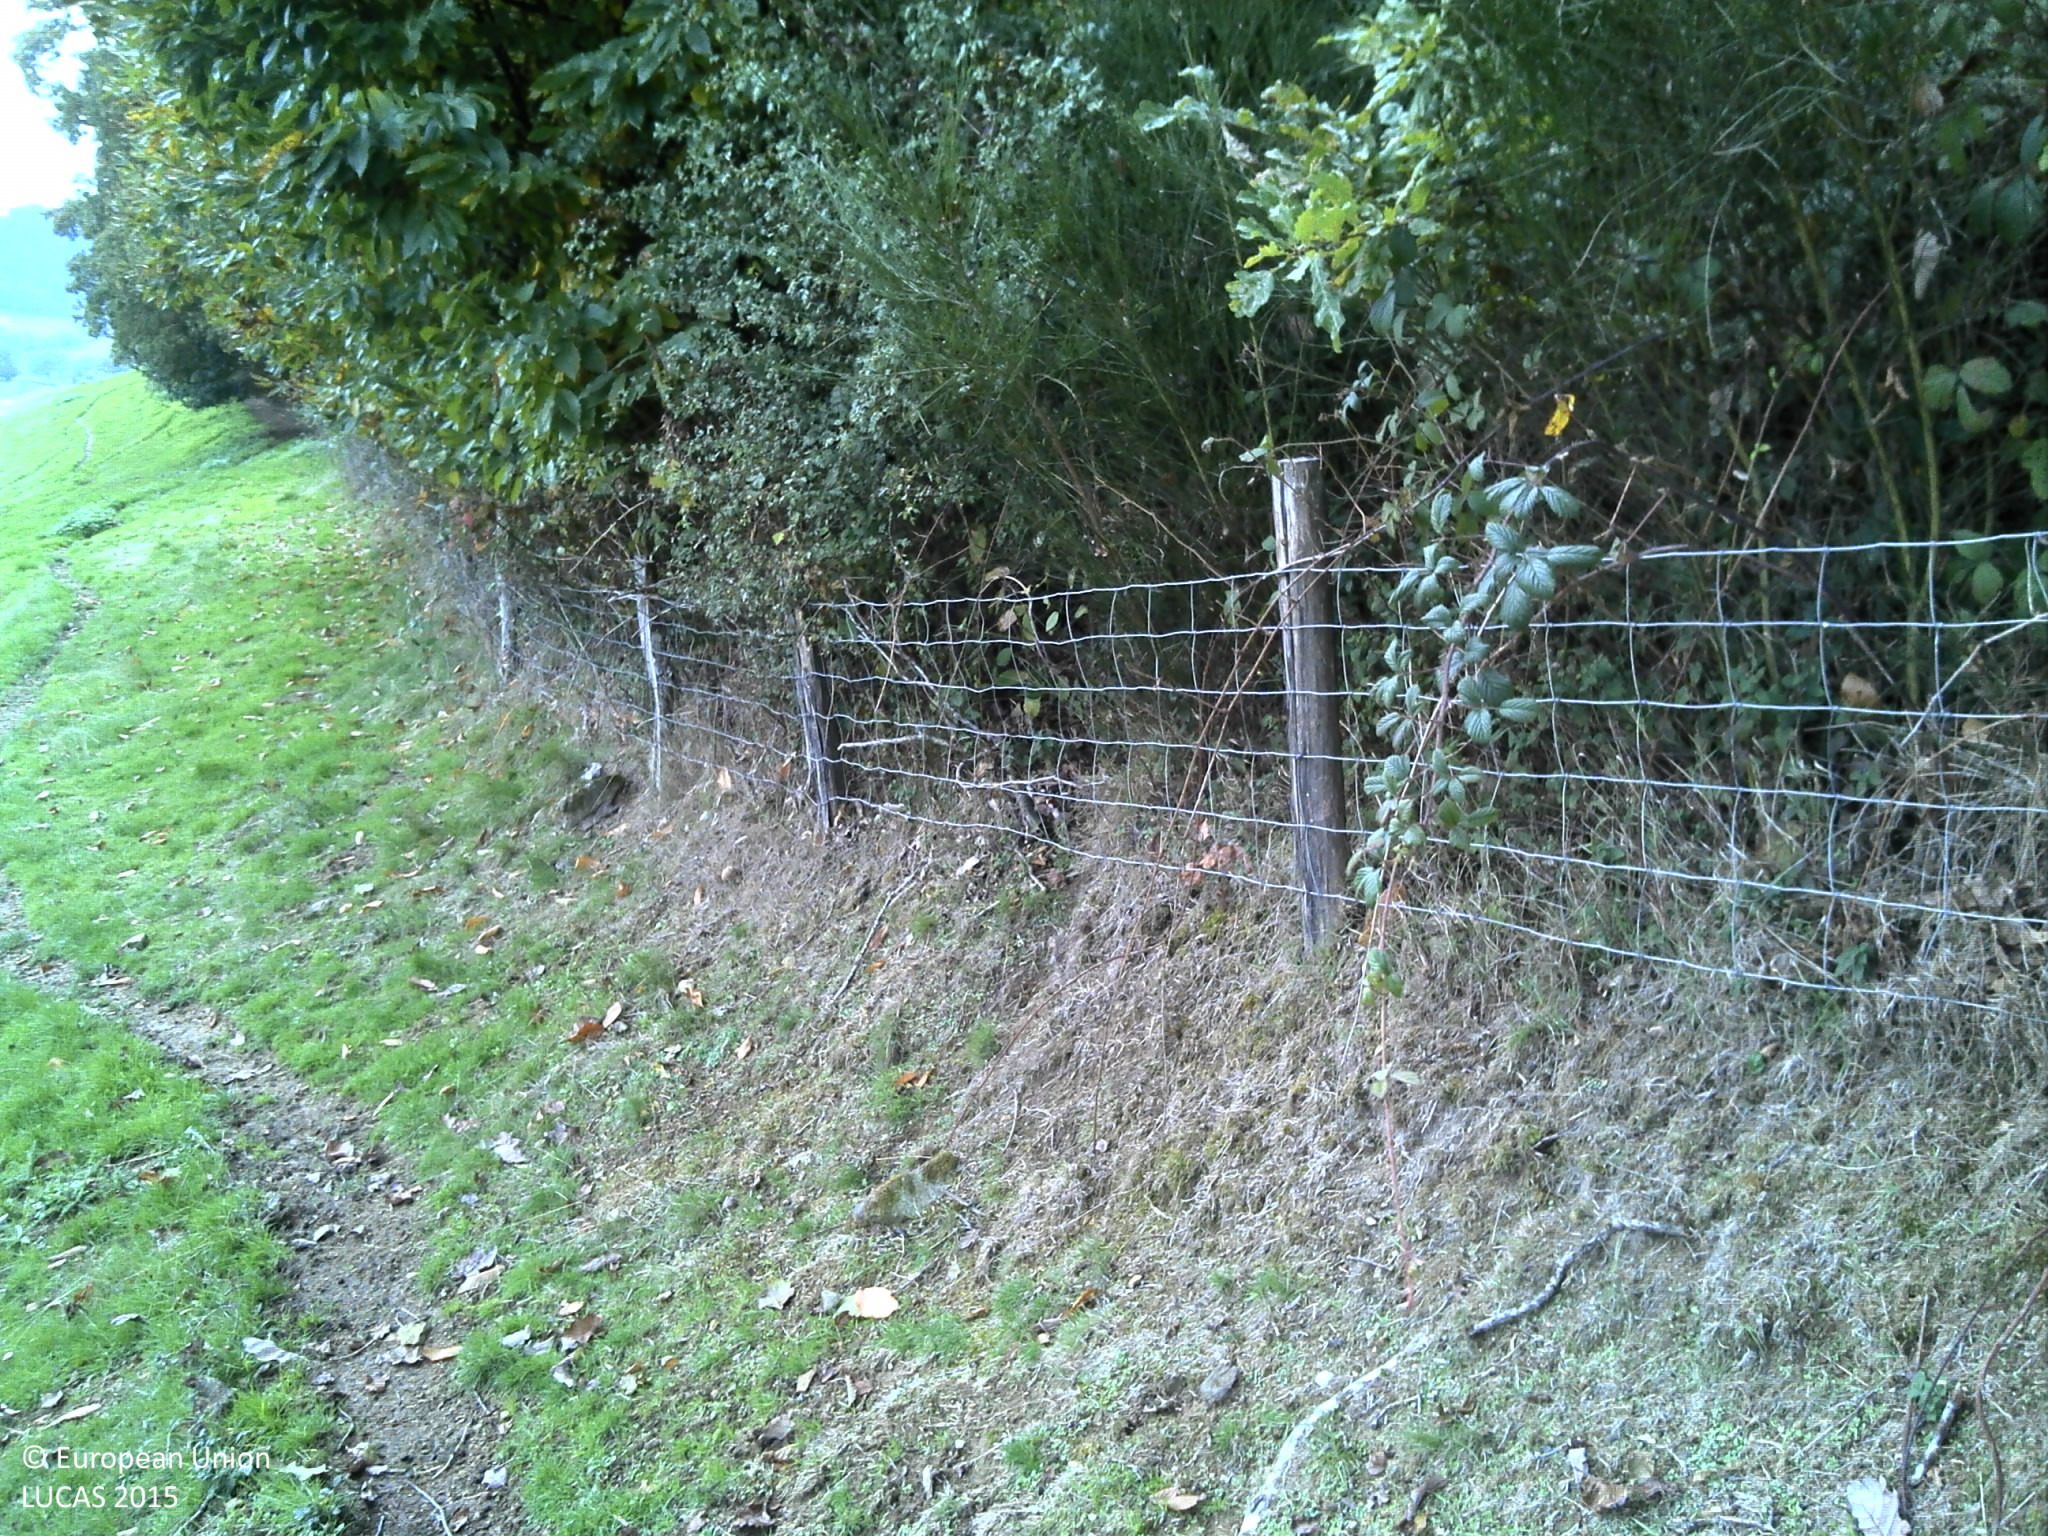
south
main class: Woodland
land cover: Broadleaved woodland
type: mesophytic deciduous forest
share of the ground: > 75 %
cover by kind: broadleaved forest trees 100 %
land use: Forestry
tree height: > 5 m
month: October
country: FR
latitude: 46.6897
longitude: 4.0242
